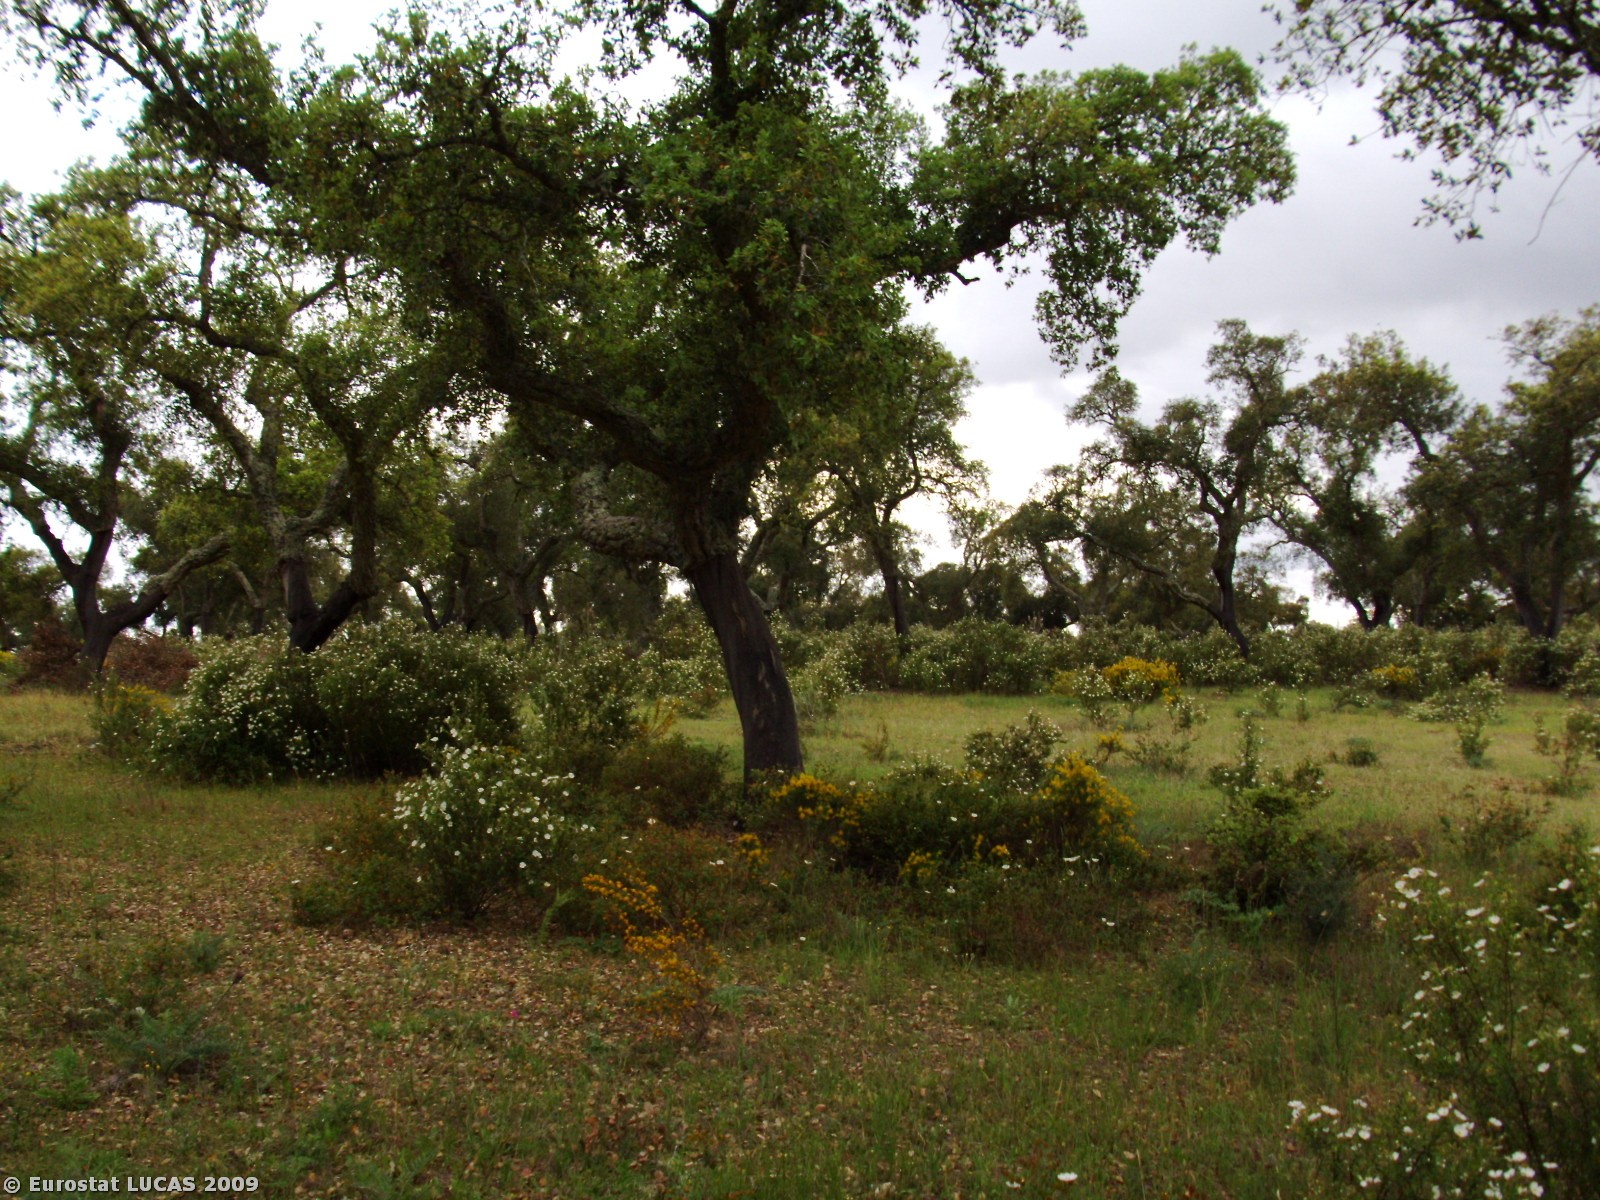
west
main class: Woodland
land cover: Broadleaved woodland
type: broadleaved evergreen forest
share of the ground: 25 - 50 %
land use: Forestry
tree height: > 5 m
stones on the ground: 25 - 50 %
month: April
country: PT
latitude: 38.5305
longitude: -7.7112
